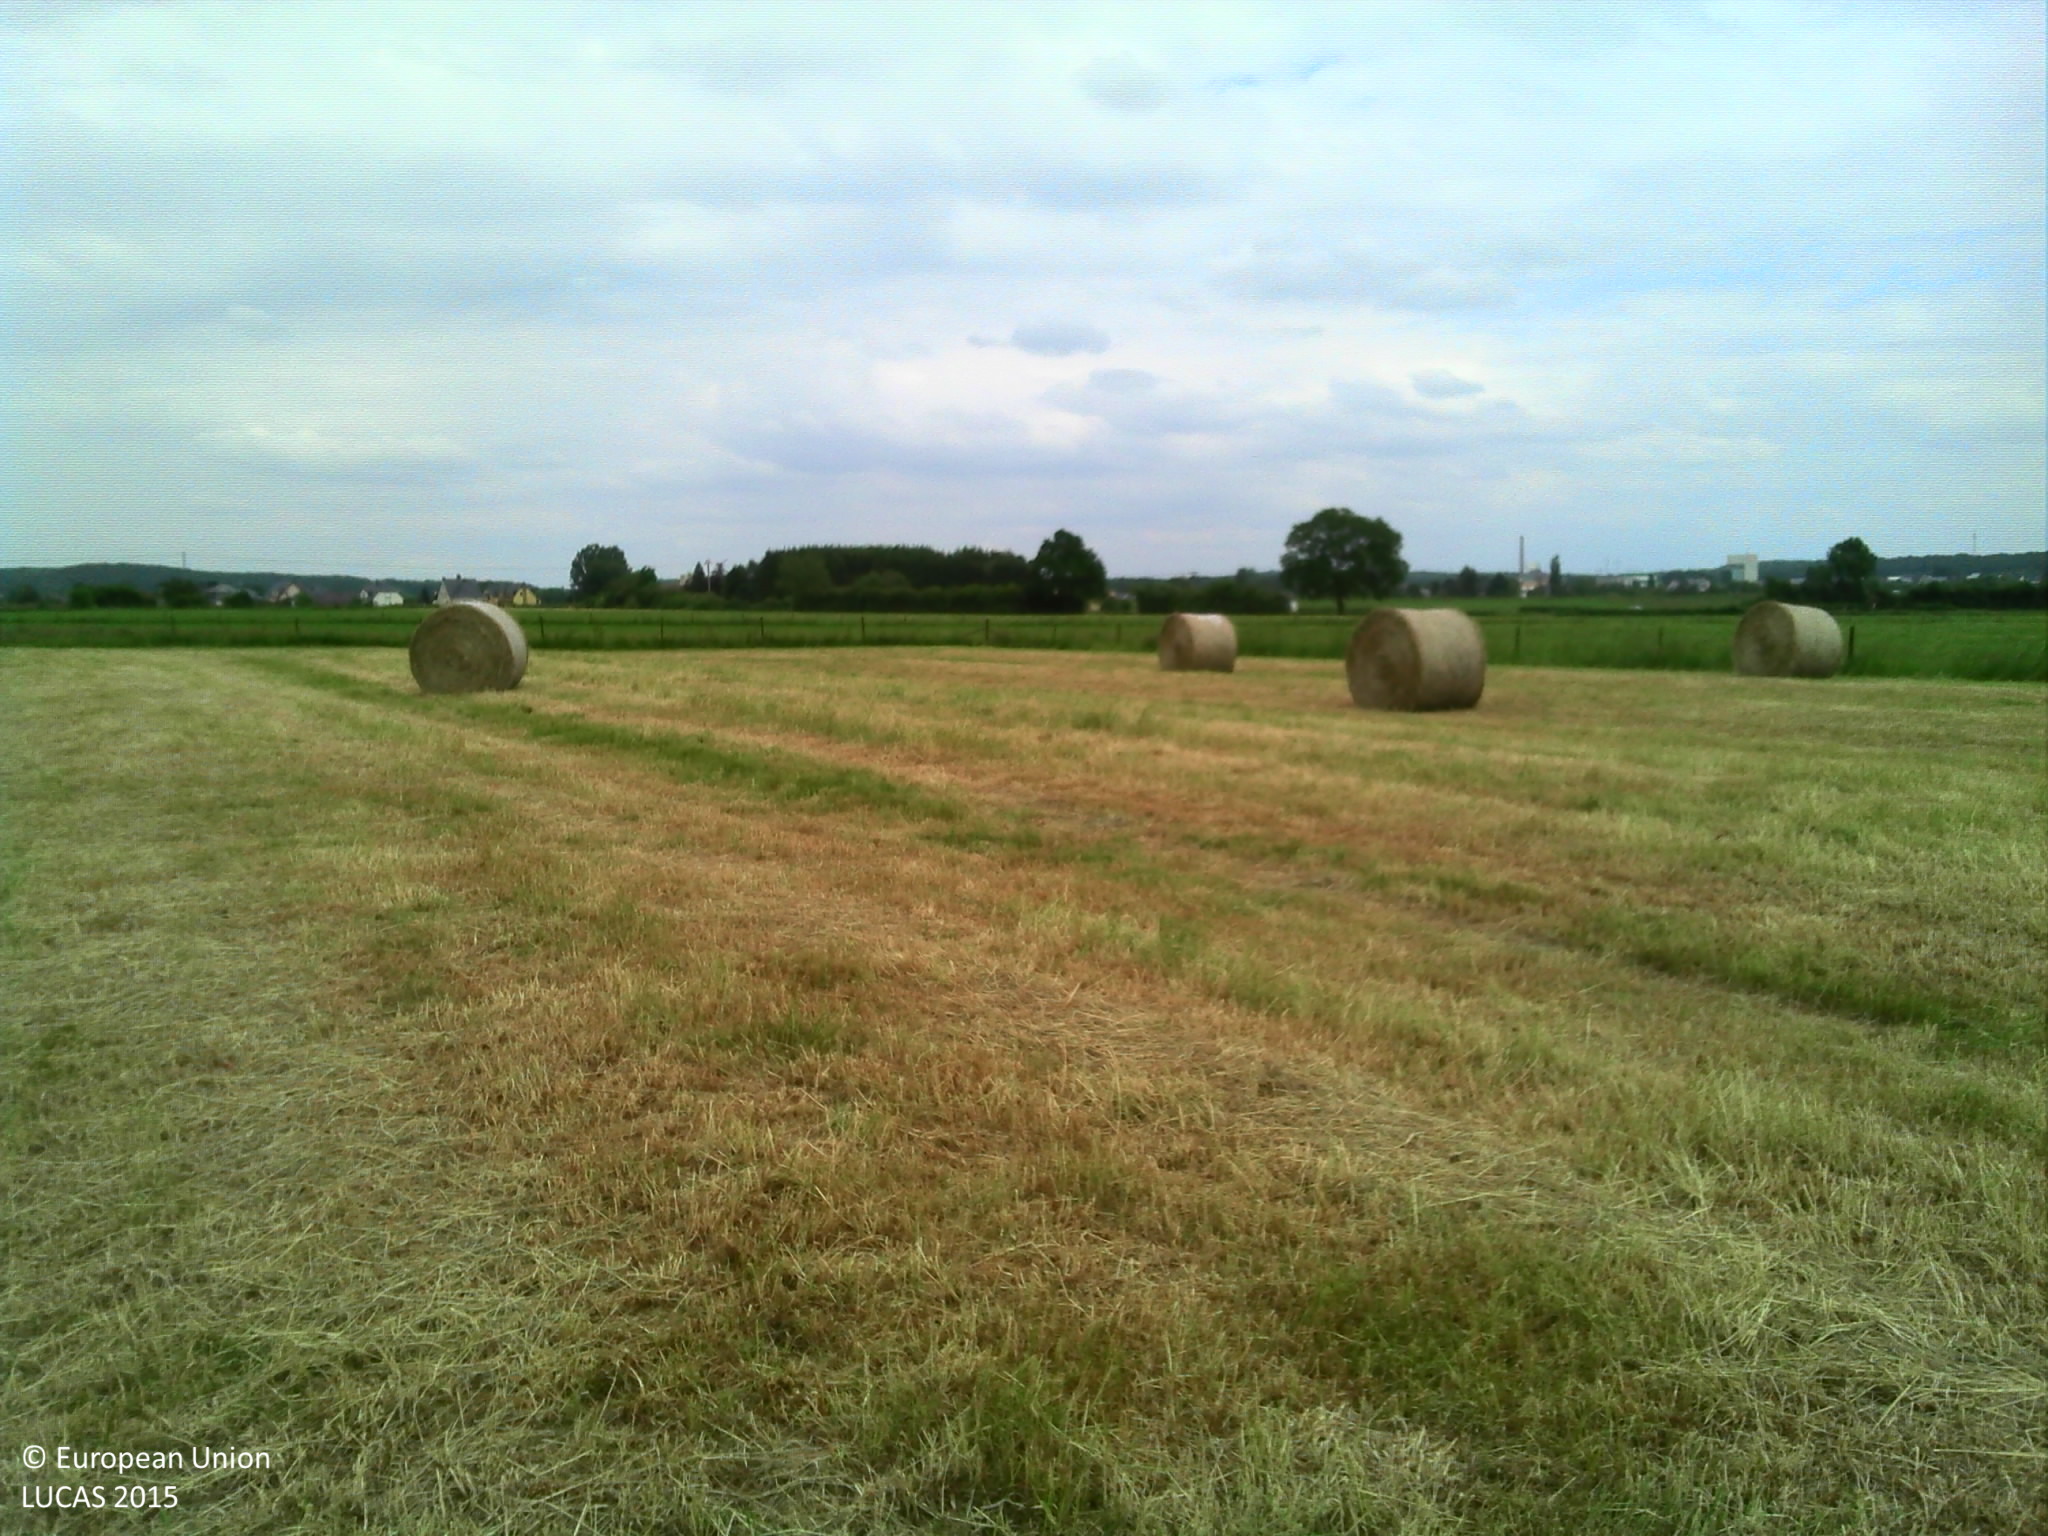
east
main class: Cropland
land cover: Temporary grasslands
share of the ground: > 75 %
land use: Agriculture (excluding fallow land and kitchen gardens)
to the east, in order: Temporary grasslands; Fences; Temporary grasslands; Fences; Temporary grasslands
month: June
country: LU
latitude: 49.5701
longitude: 5.8923
